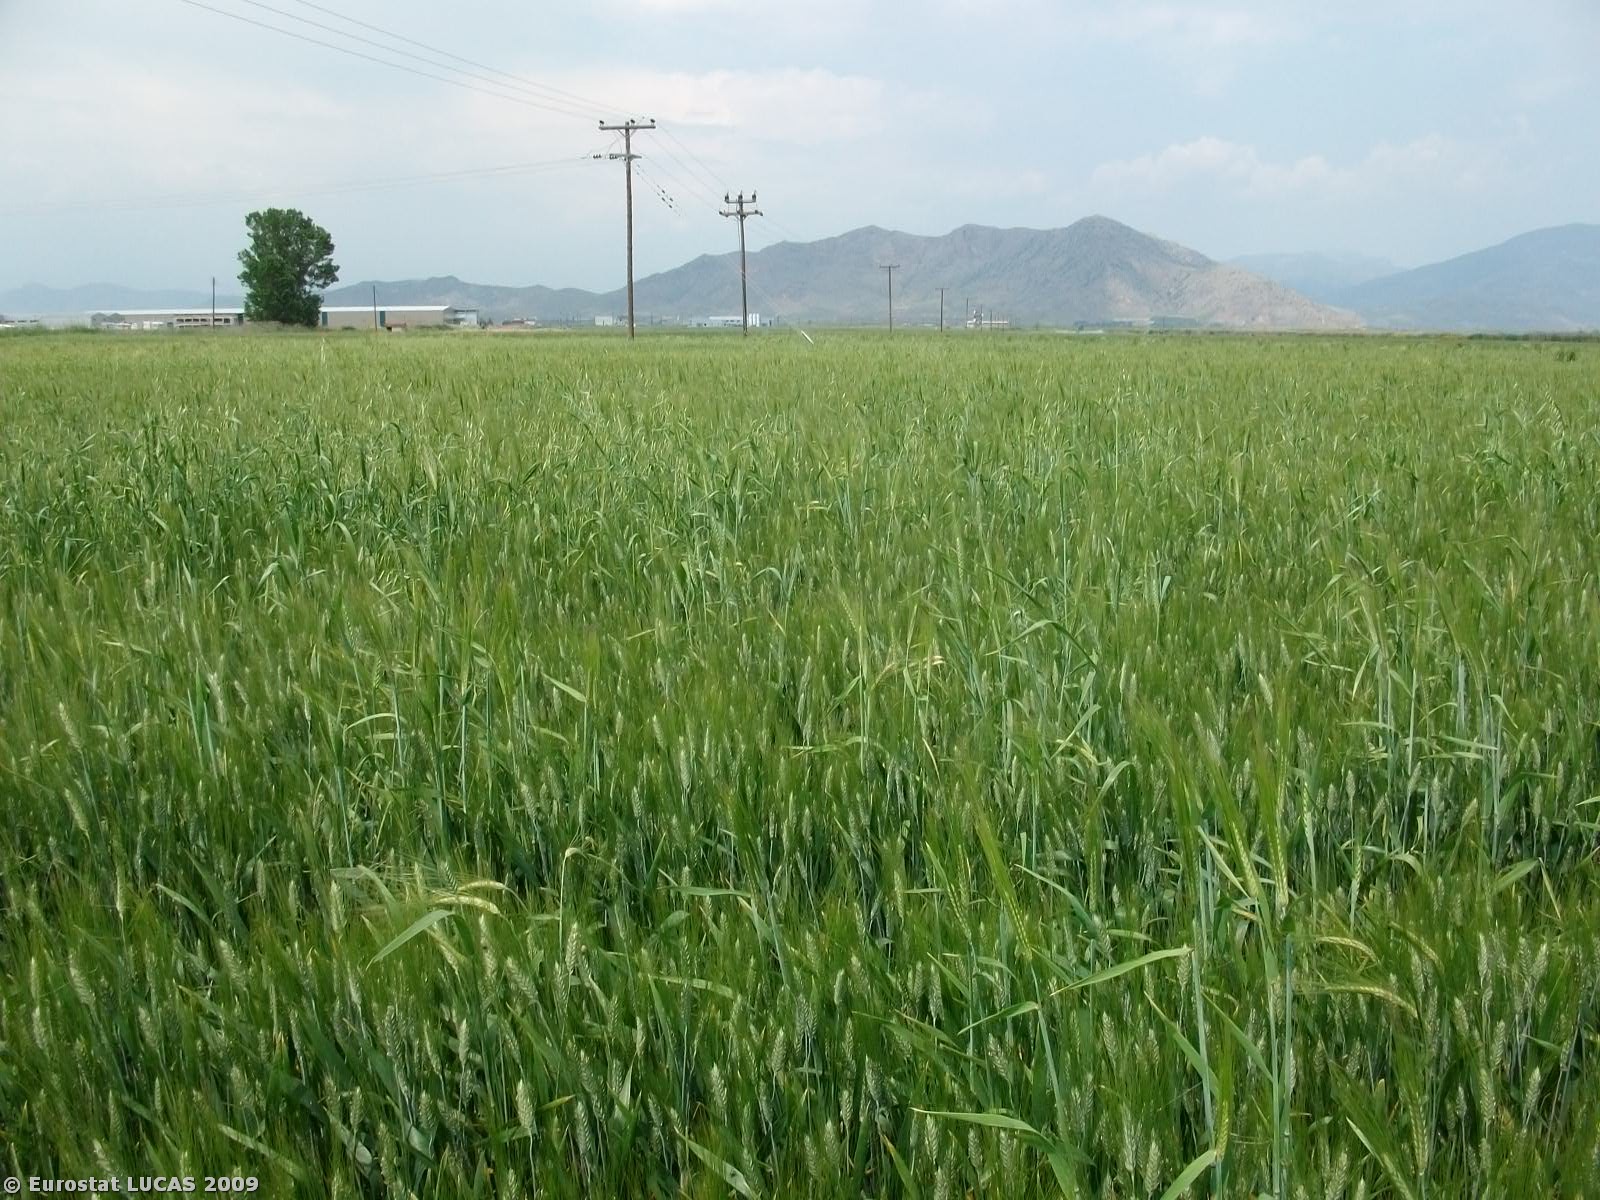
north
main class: Cropland
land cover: Durum wheat
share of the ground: > 75 %
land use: Agriculture (excluding fallow land and kitchen gardens)
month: May
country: GR
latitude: 39.6450
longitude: 22.5180
